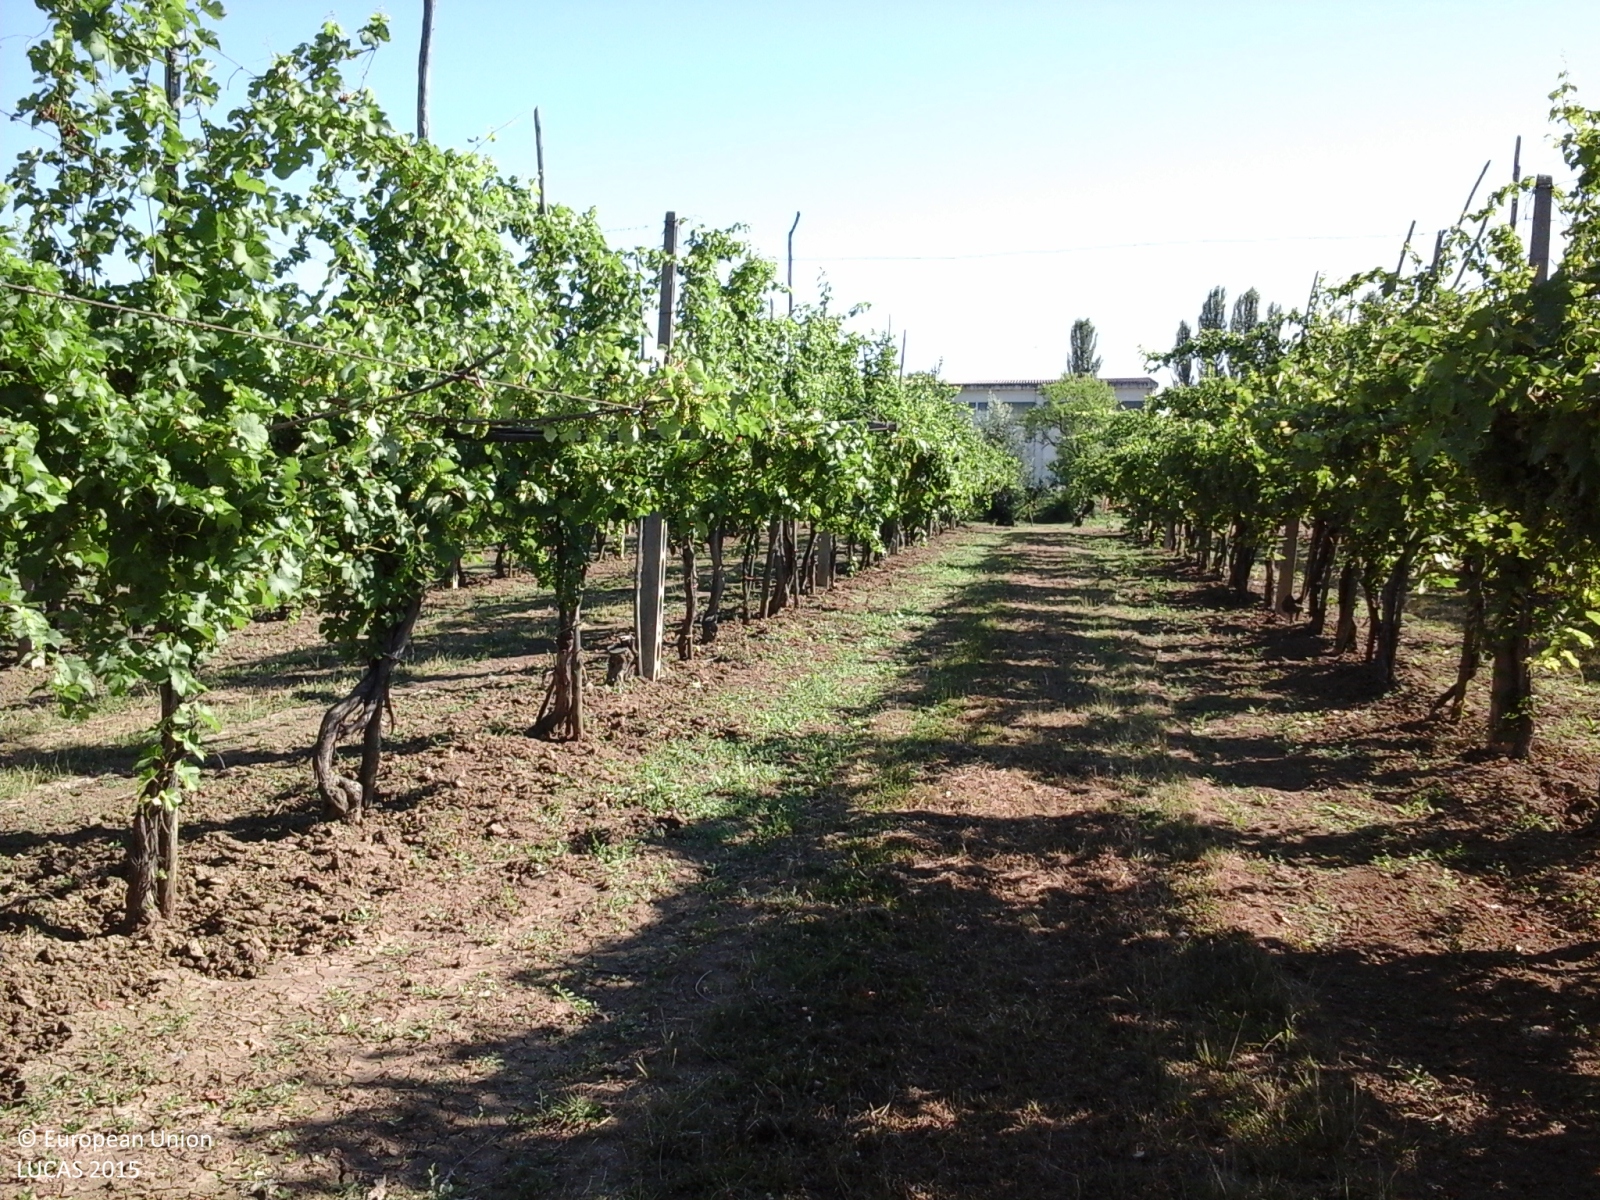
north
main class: Cropland
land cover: Vineyards
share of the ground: 25 - 50 %
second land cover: Grassland without tree/shrub cover
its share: > 75 %
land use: Agriculture (excluding fallow land and kitchen gardens)
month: July
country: IT
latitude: 44.4286
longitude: 11.5918
